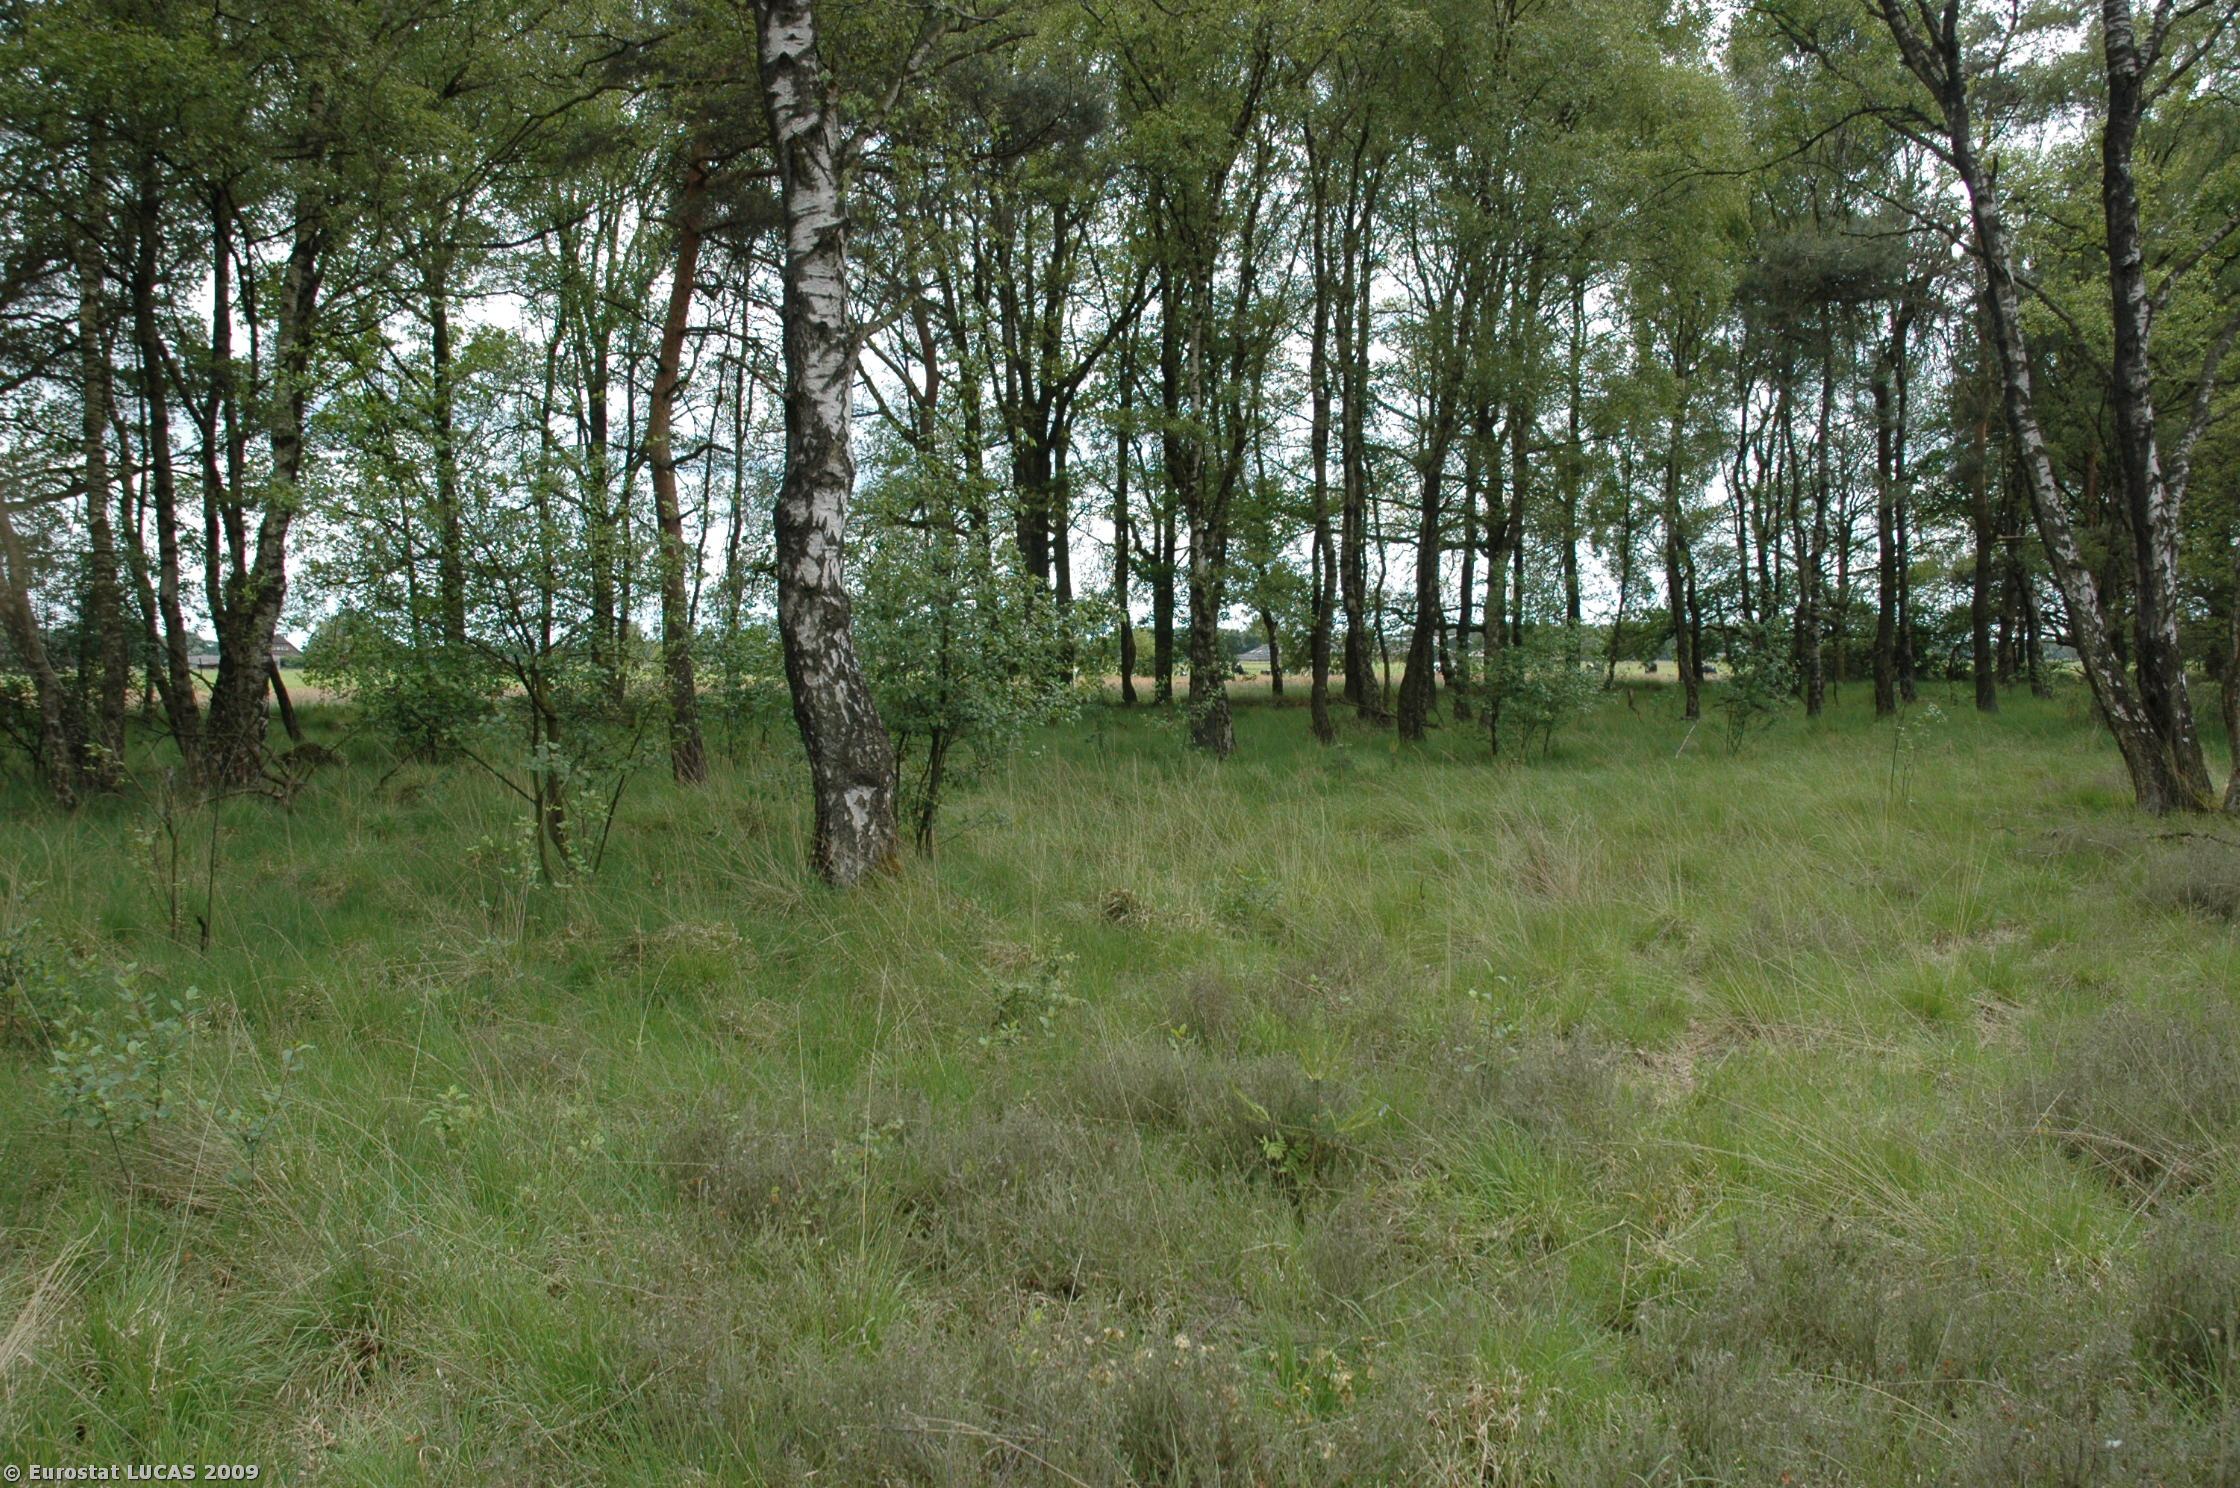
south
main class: Shrubland
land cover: Shrubland without tree cover
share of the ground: > 75 %
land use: Nature reserves
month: June
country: NL
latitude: 52.1335
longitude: 6.0985
